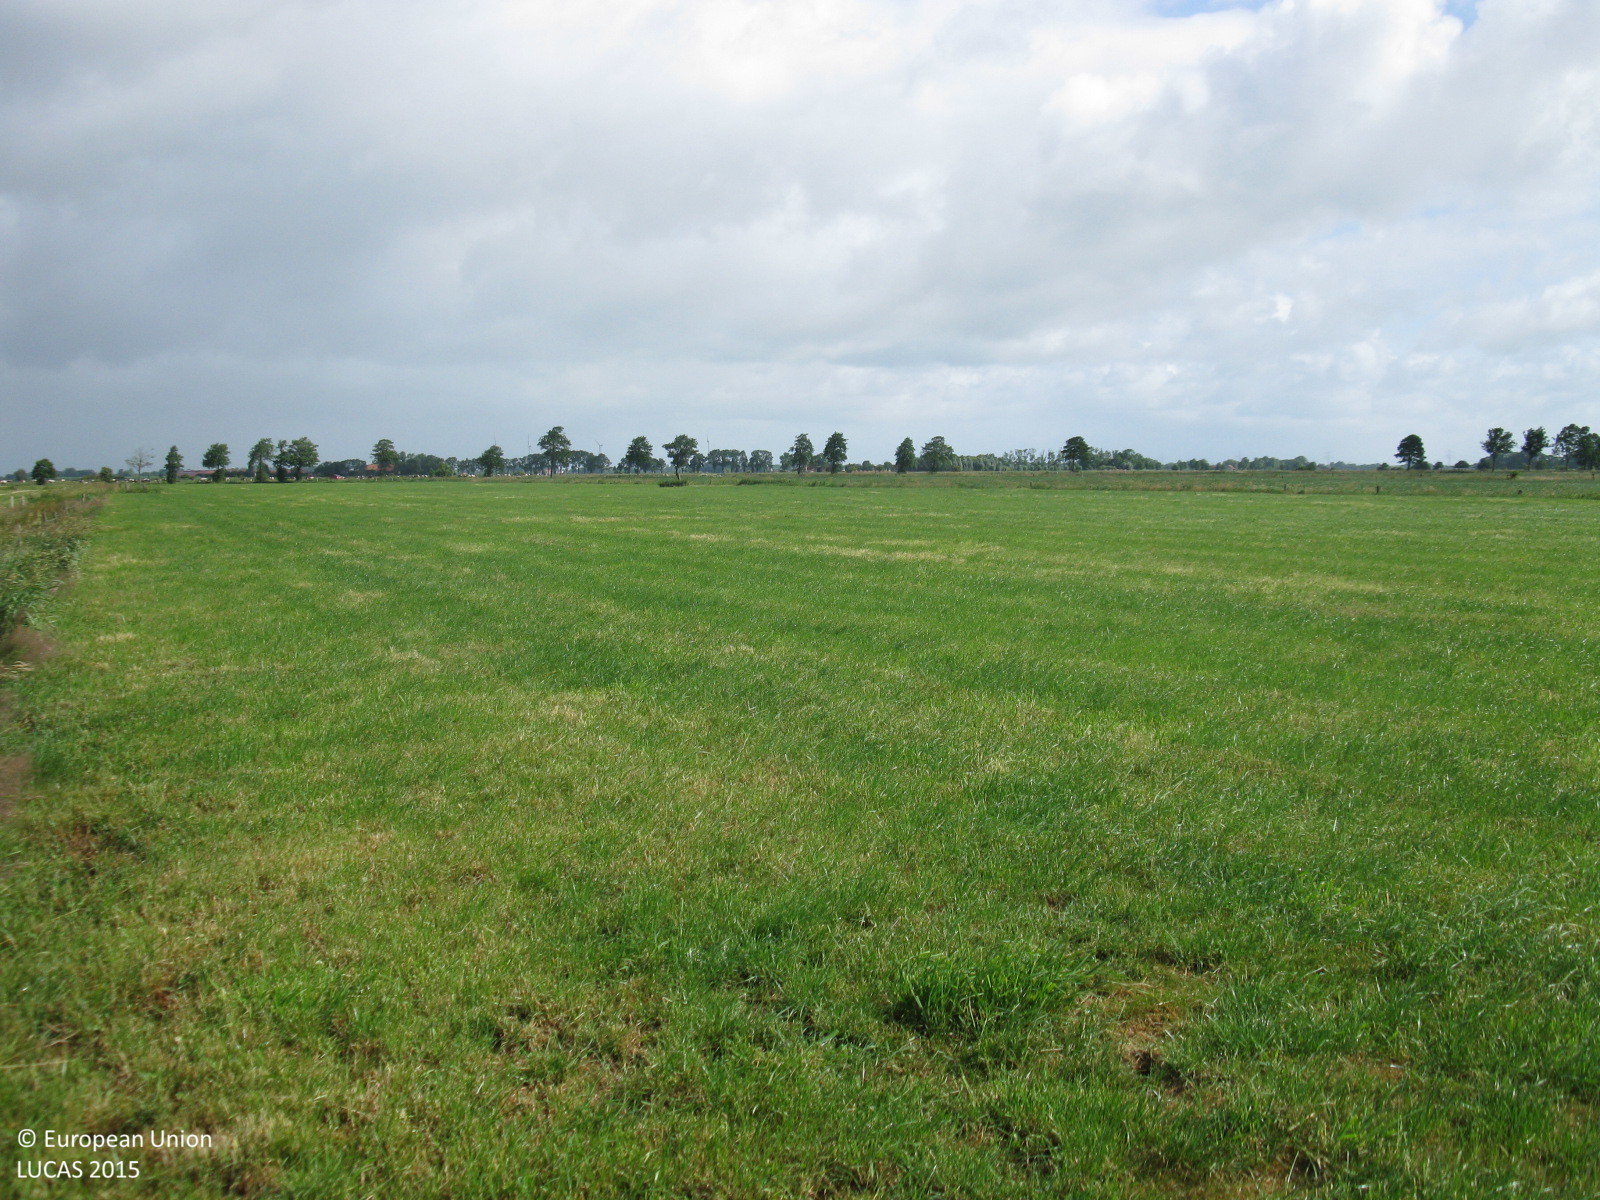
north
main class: Grassland
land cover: Grassland without tree/shrub cover
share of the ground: > 75 %
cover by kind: herbaceous plants 100 %
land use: Agriculture (excluding fallow land and kitchen gardens)
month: July
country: DE
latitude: 53.4388
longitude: 7.9684
